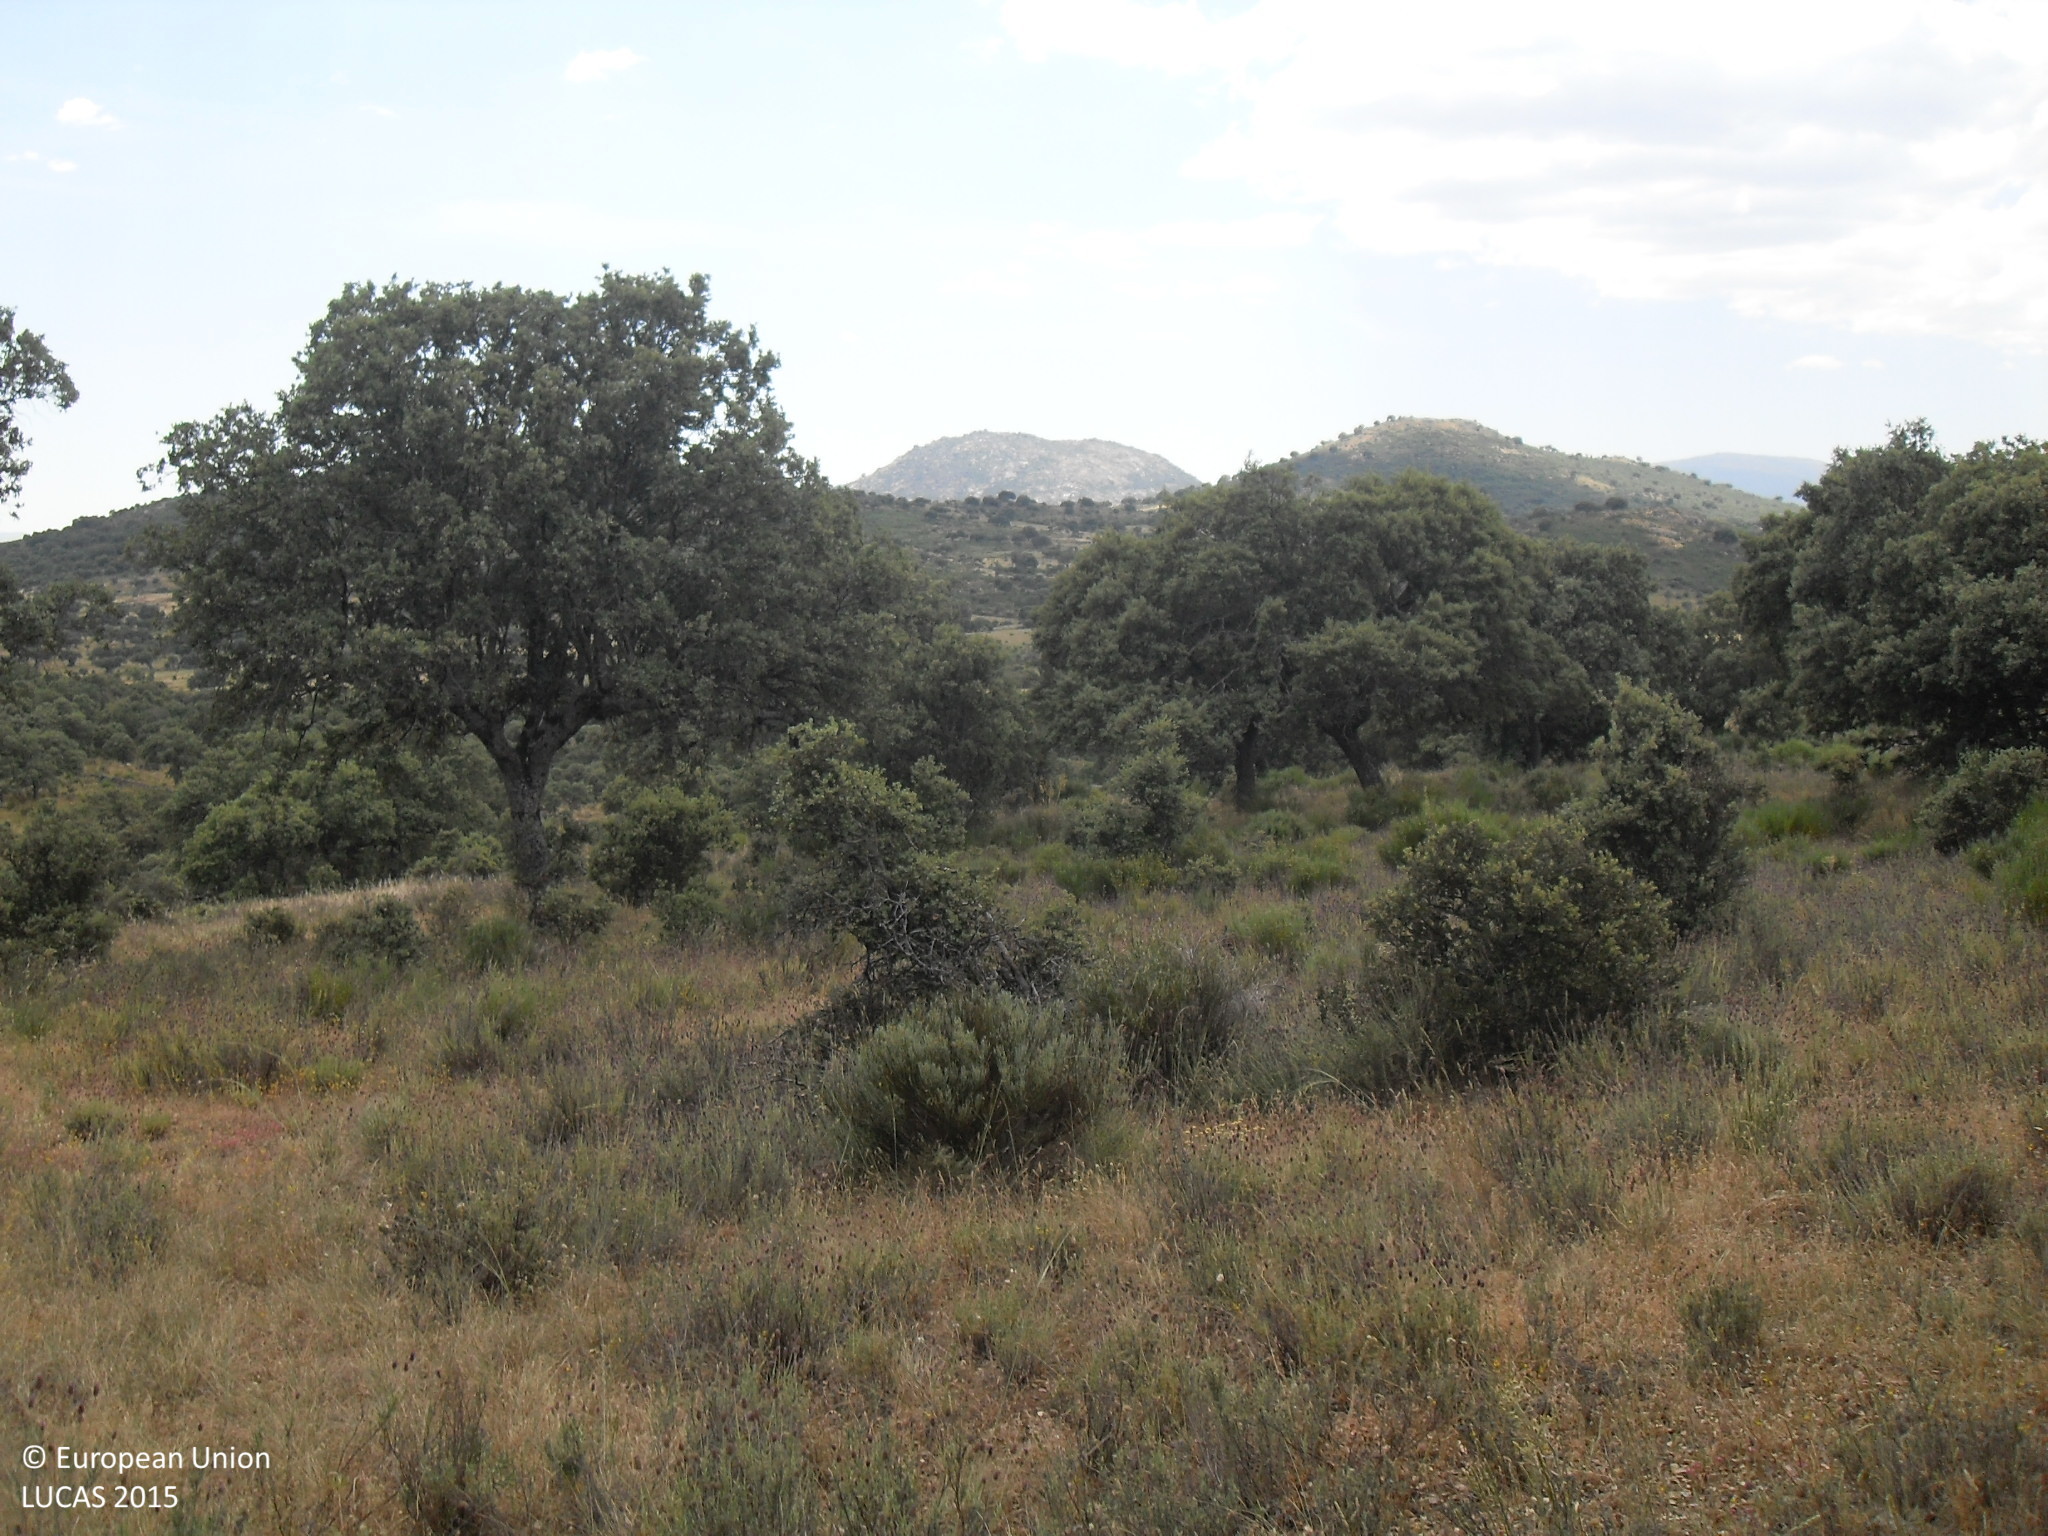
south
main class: Woodland
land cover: Broadleaved woodland
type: broadleaved evergreen forest
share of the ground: 25 - 50 %
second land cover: Grassland without tree/shrub cover
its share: 50 - 75 %
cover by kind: herbaceous plants 65 %, broadleaved forest trees 35 %
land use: Forestry
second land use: Agriculture (excluding fallow land and kitchen gardens)
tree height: > 5 m
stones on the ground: < 10 %
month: June
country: ES
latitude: 40.5095
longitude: -5.5399
